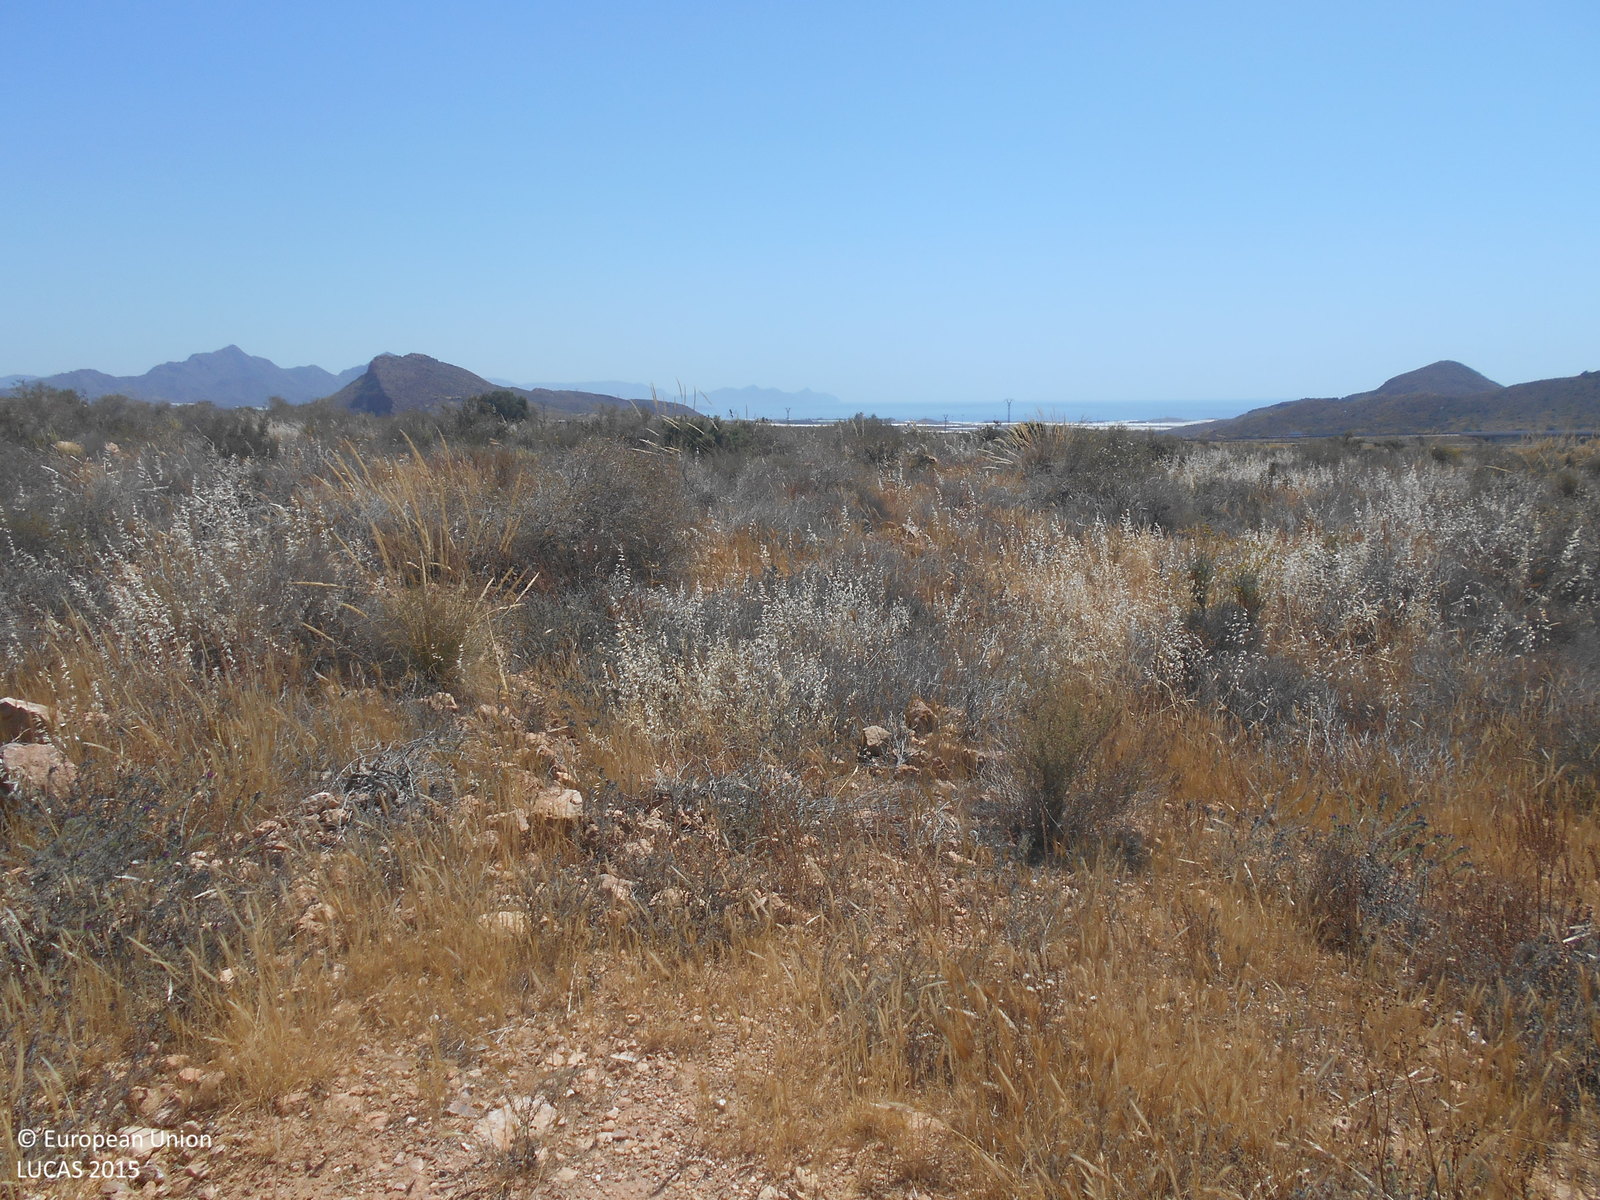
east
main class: Shrubland
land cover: Shrubland without tree cover
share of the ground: 50 - 75 %
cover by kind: herbaceous plants 40 %, shrubs 20 %, consolidated bare surface 20 %, unconsolidated bare surface 20 %
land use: Semi-natural and natural areas not in use
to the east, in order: Shrubland without tree cover; Tracks; Shrubland without tree cover; Rocks and stones; Tracks; Shrubland without tree cover; Tracks; Shrubland without tree cover; Rocks and stones; Ditches and canals; Rocks and stones; Shrubland without tree cover
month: May
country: ES
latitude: 37.5481
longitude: -1.4456
